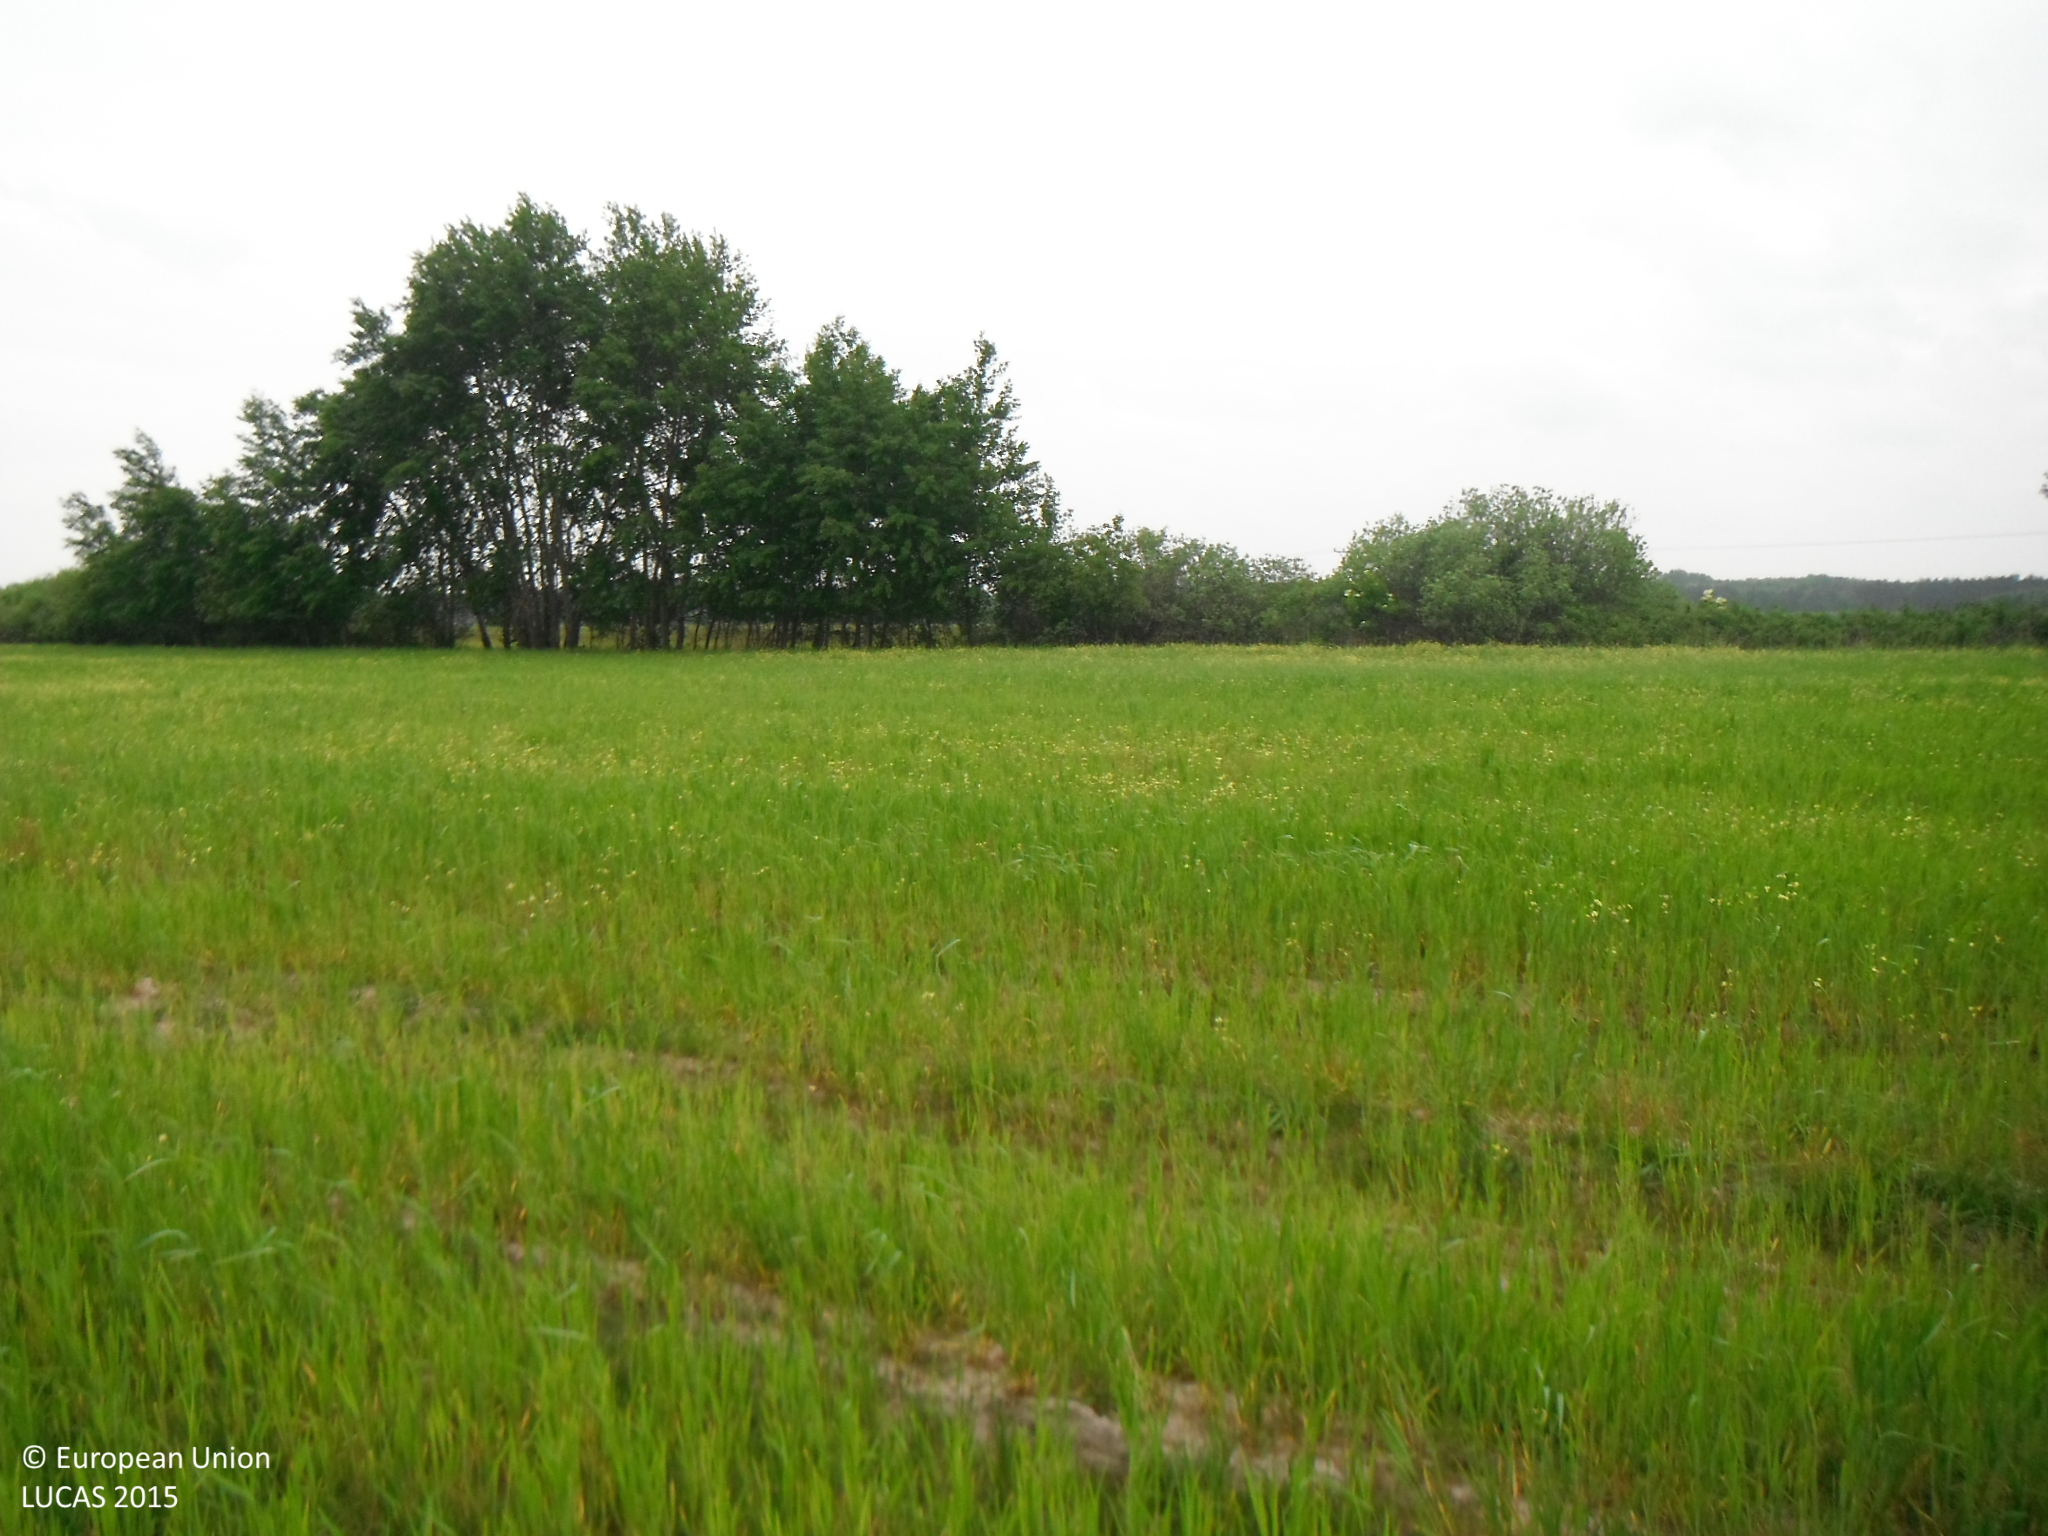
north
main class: Cropland
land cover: Rye
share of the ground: 50 - 75 %
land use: Agriculture (excluding fallow land and kitchen gardens)
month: May
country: SK
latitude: 48.6673
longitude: 17.0286
